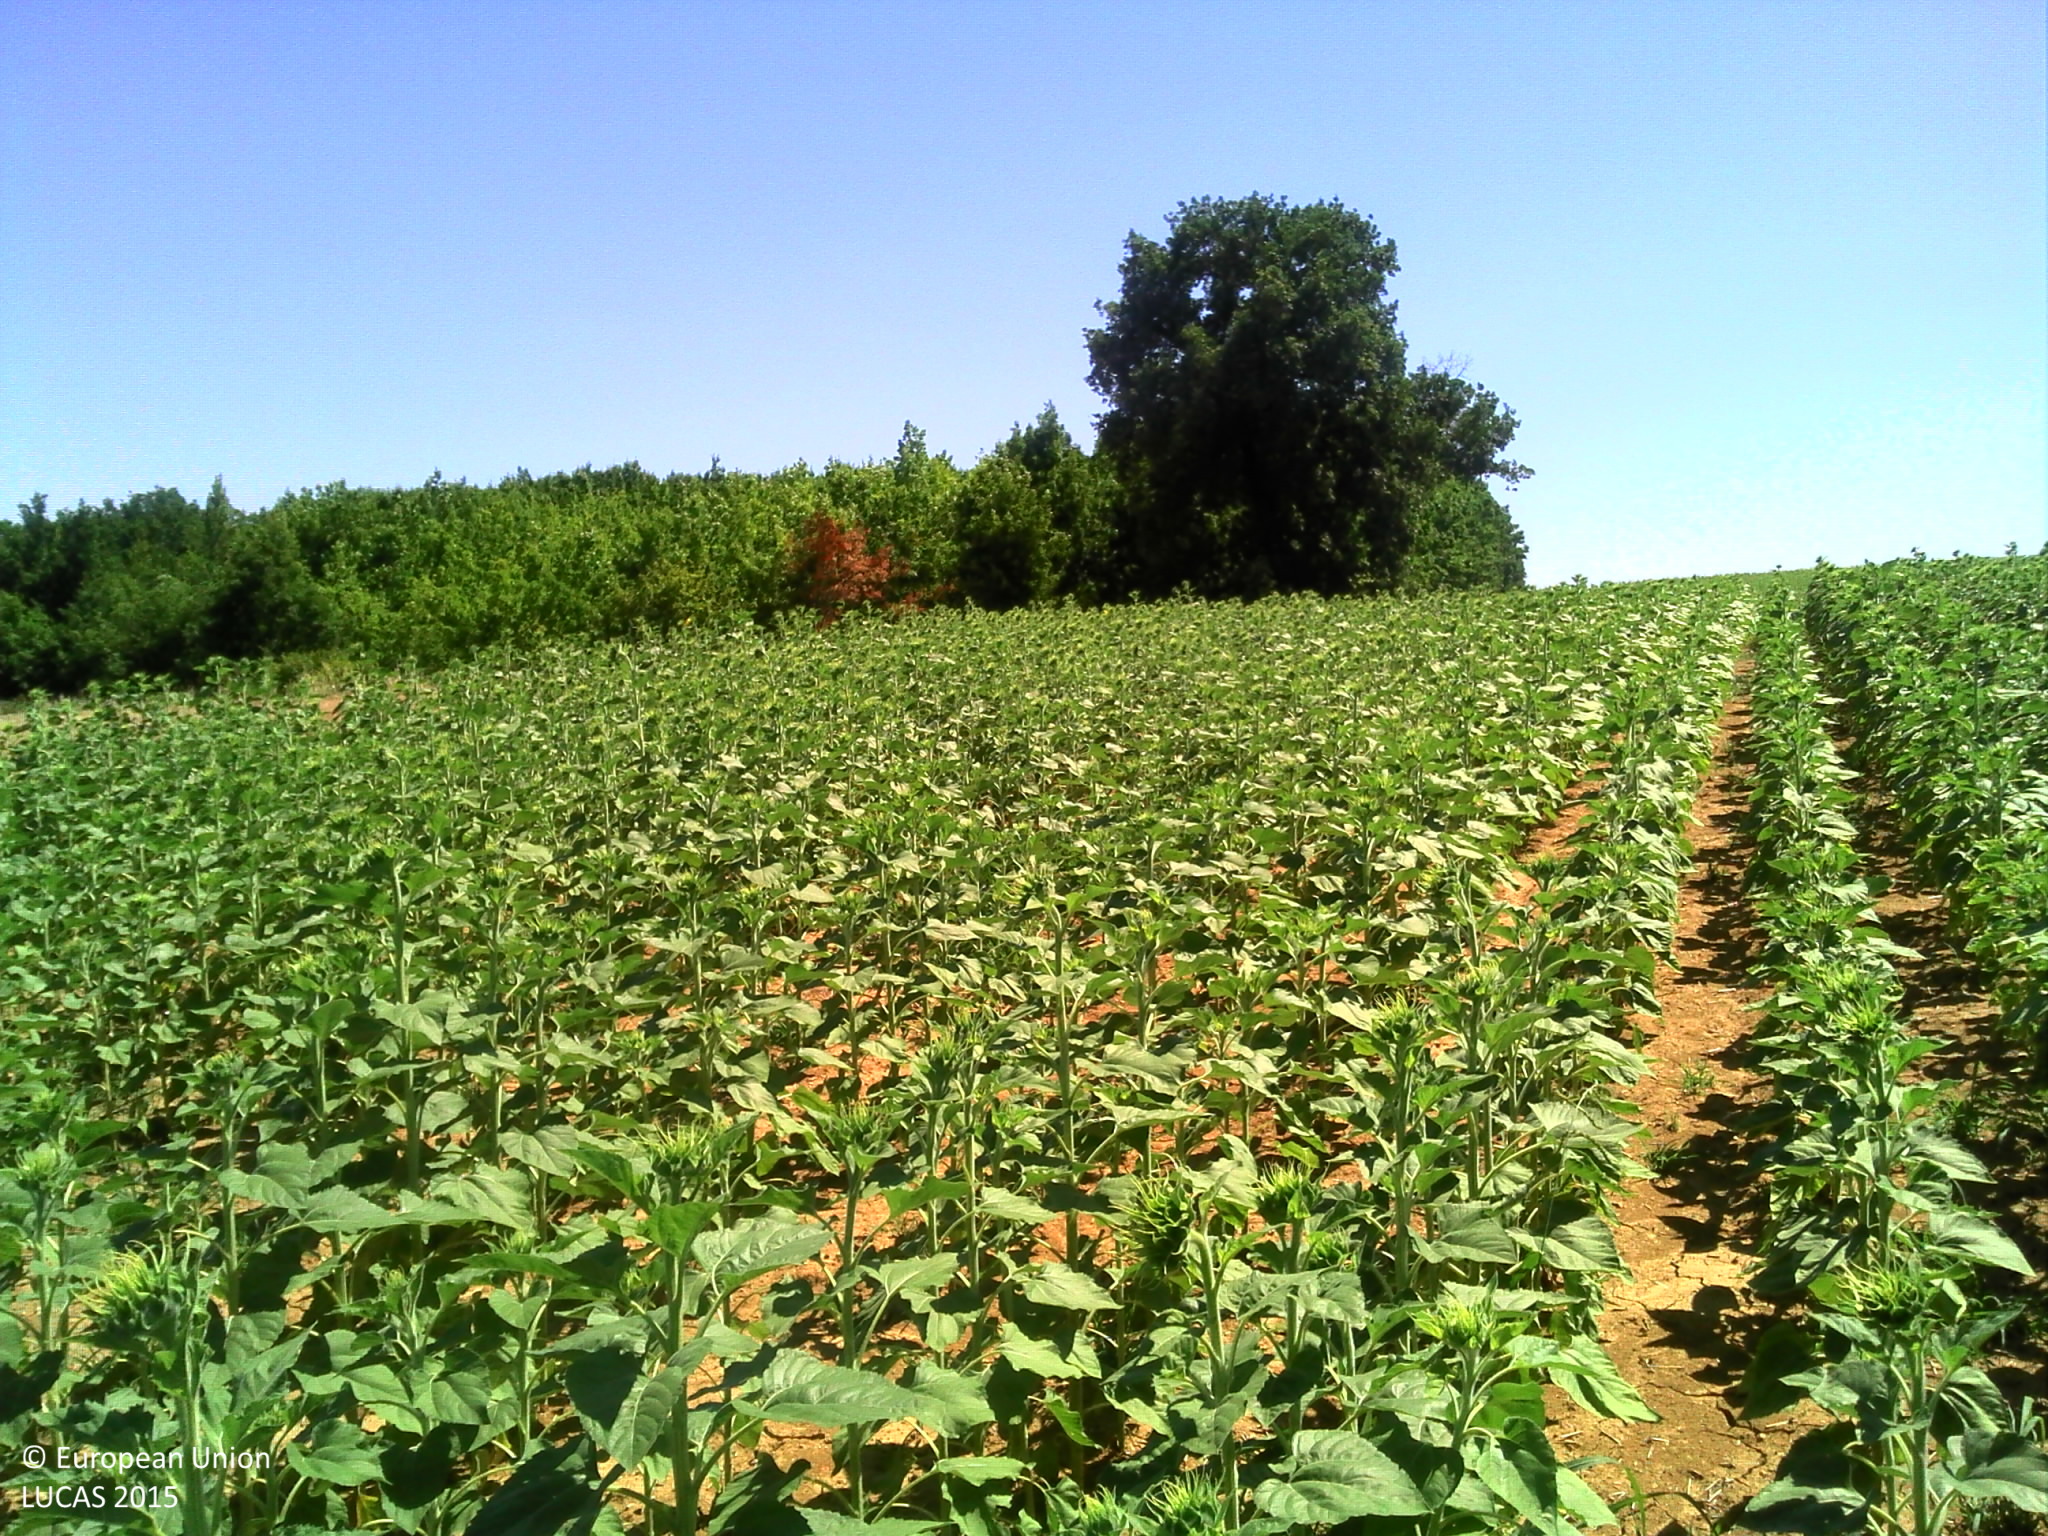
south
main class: Cropland
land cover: Sunflower
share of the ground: > 75 %
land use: Agriculture (excluding fallow land and kitchen gardens)
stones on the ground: < 10 %
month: July
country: FR
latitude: 44.0051
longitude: 0.7047
